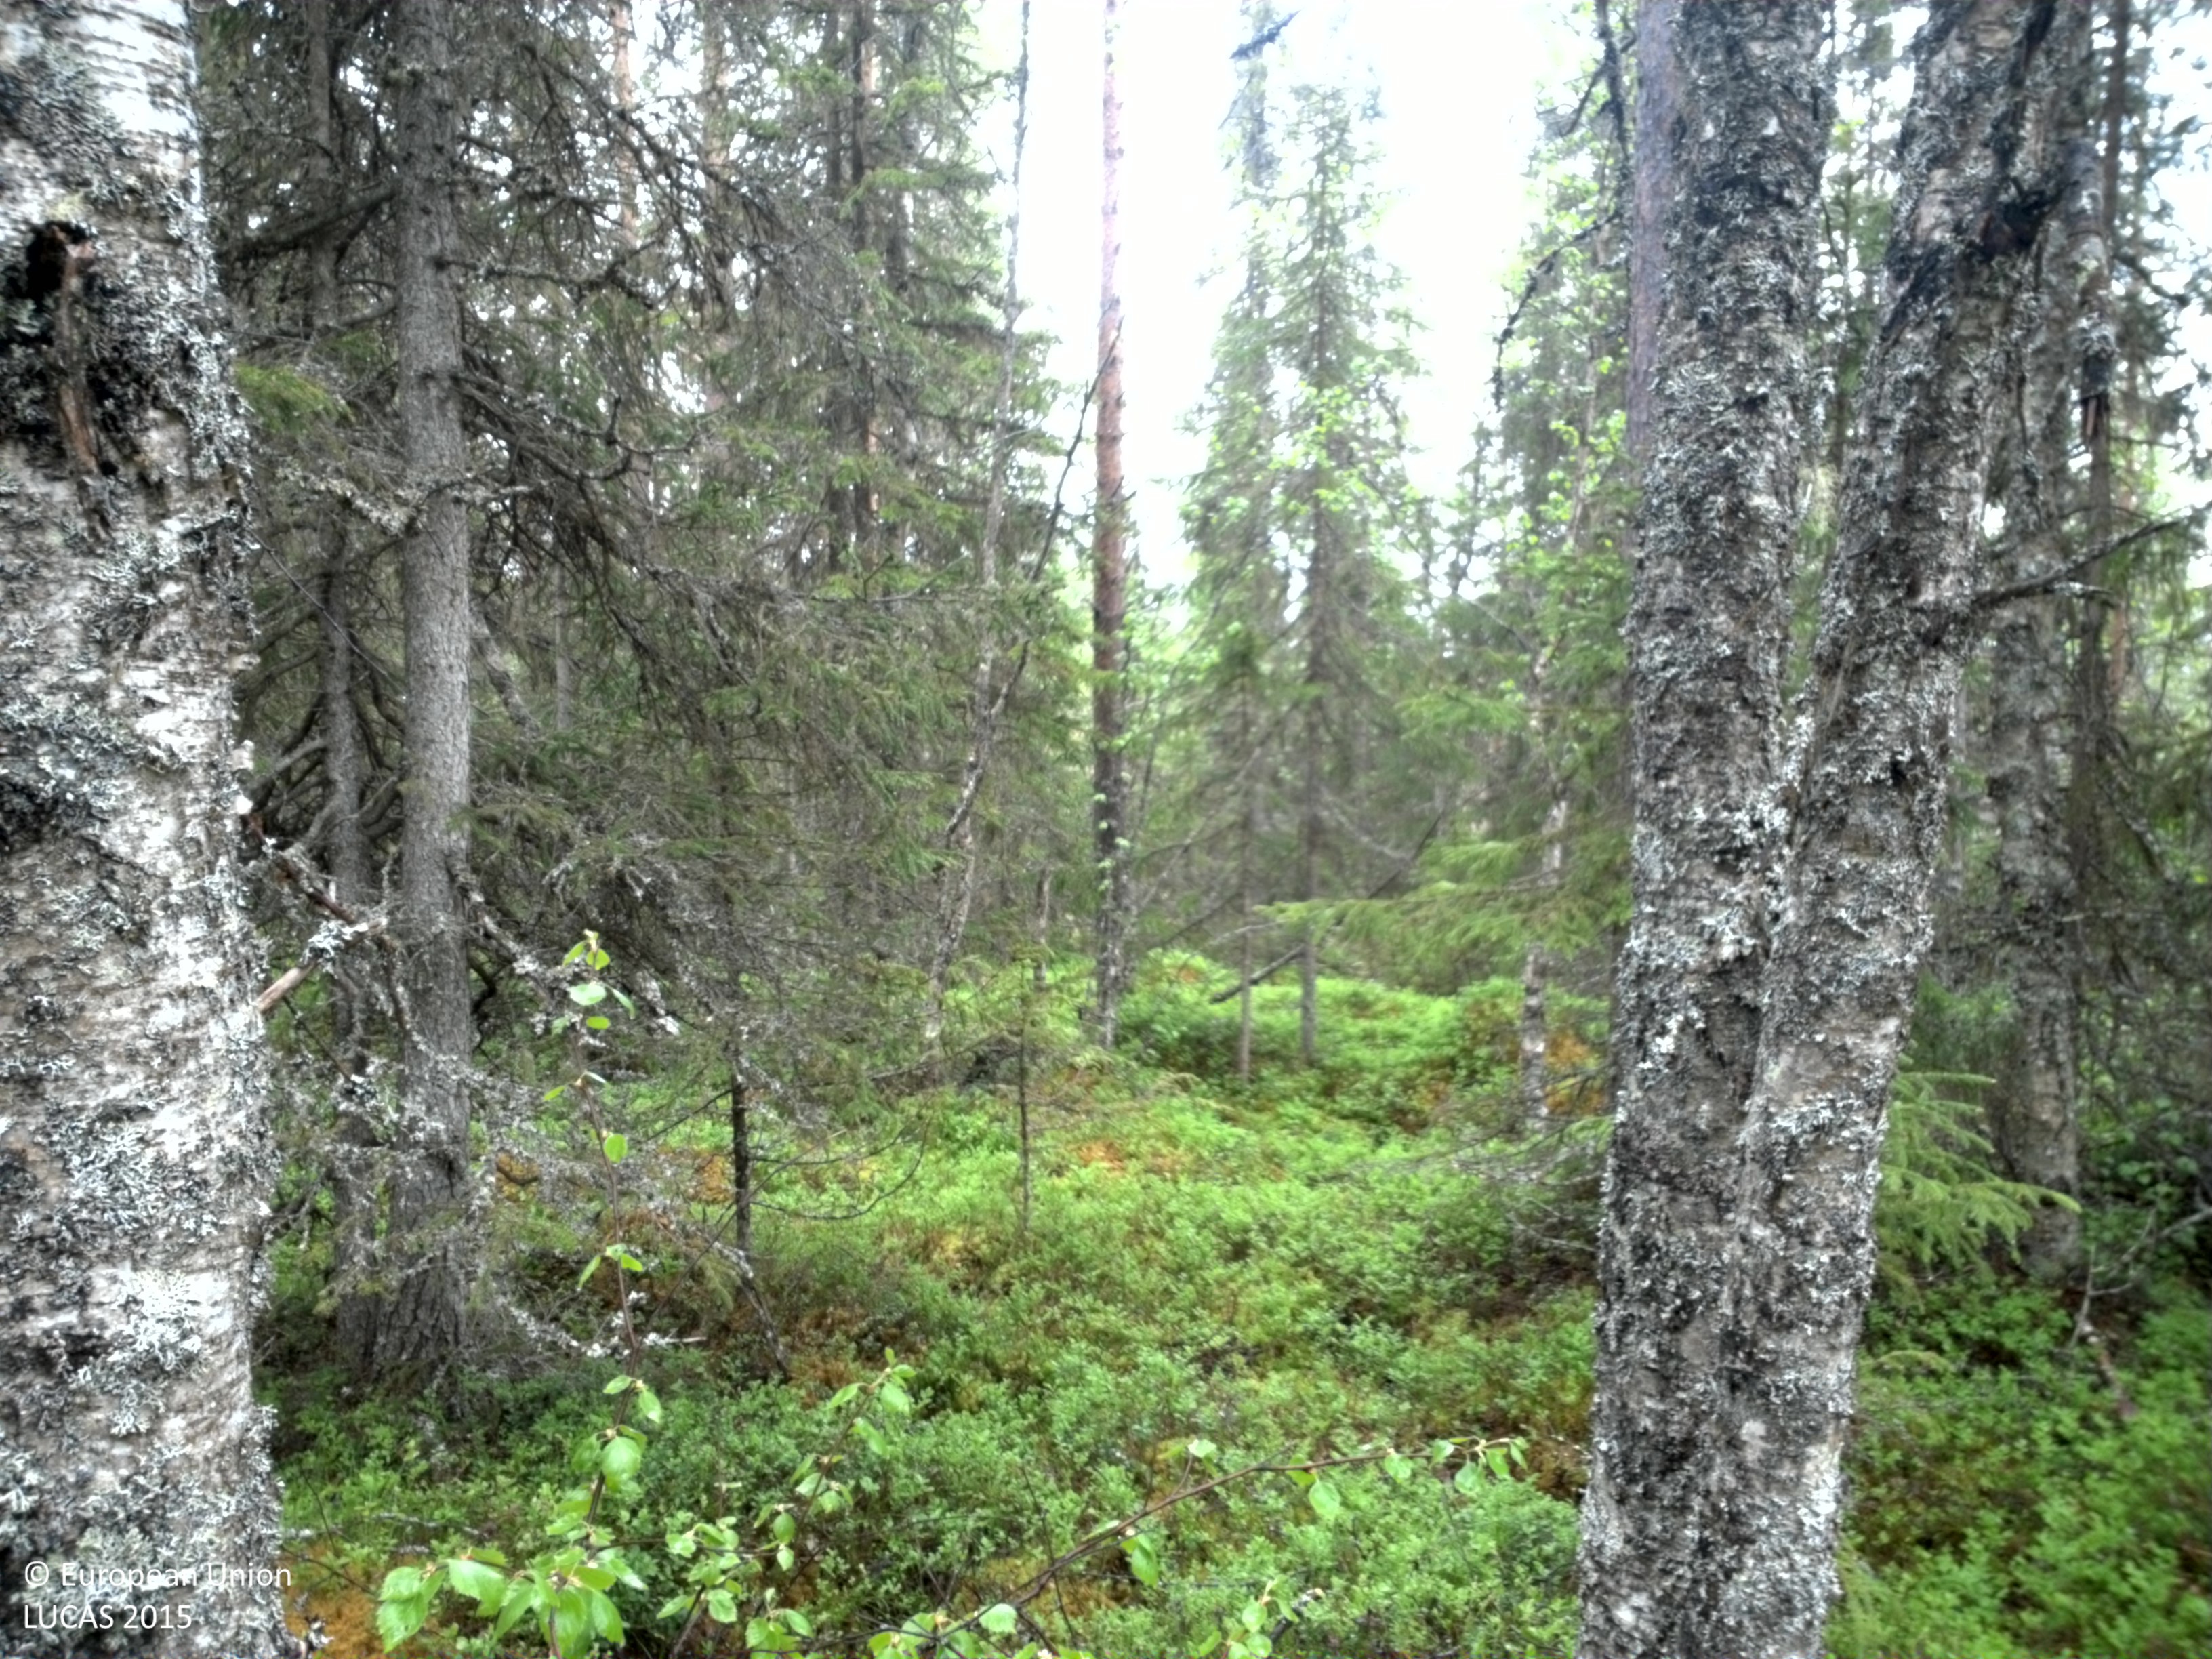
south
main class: Woodland
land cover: Other mixed woodland
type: boreal forest
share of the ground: 50 - 75 %
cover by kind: coniferous forest trees 50 %, broadleaved forest trees 20 %, shrubs 20 %, lichens and mosses 10 %
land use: Forestry
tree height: > 5 m
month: June
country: SE
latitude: 62.0990
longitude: 13.6441
